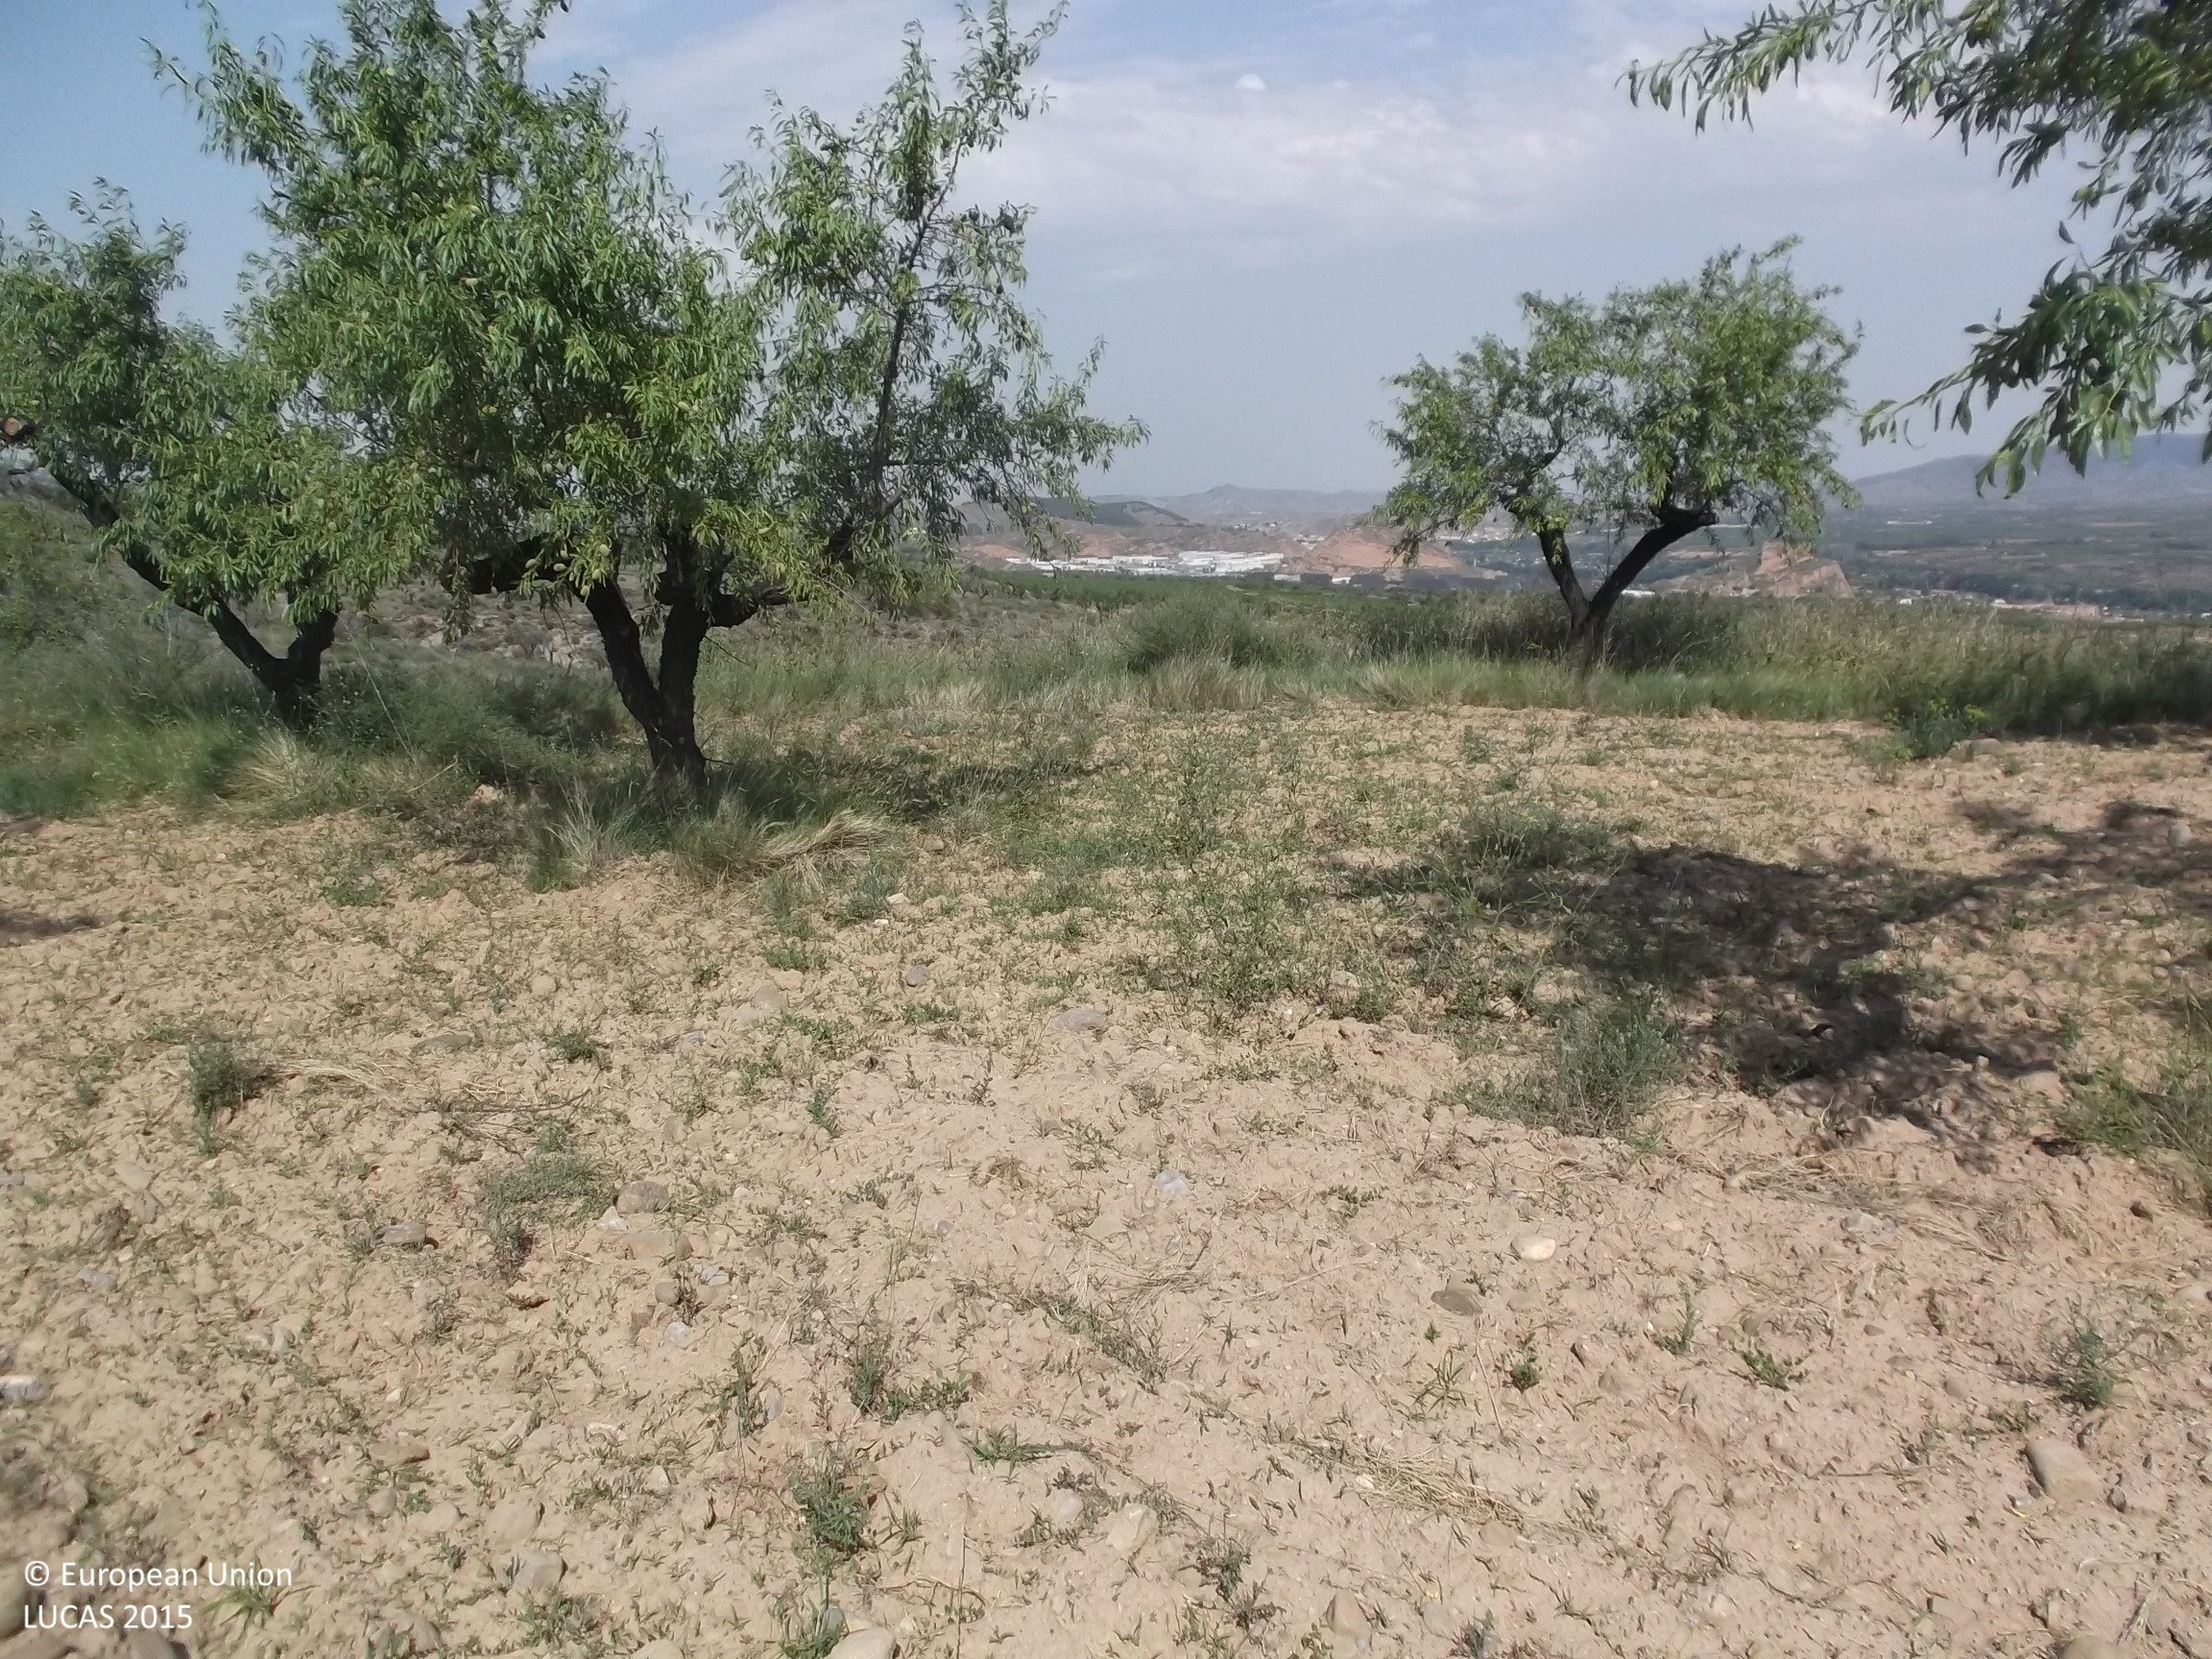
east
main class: Cropland
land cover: Nuts trees
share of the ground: 10 - 25 %
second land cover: Other bare soil
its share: > 75 %
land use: Agriculture (excluding fallow land and kitchen gardens)
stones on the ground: 10 - 25 %
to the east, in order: Nuts trees; Other bare soil; Shrubland without tree cover; Other bare soil; Nuts trees; Shrubland without tree cover; Other bare soil; Grass margins; Nuts trees
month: July
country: ES
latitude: 42.2335
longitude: -2.1196
